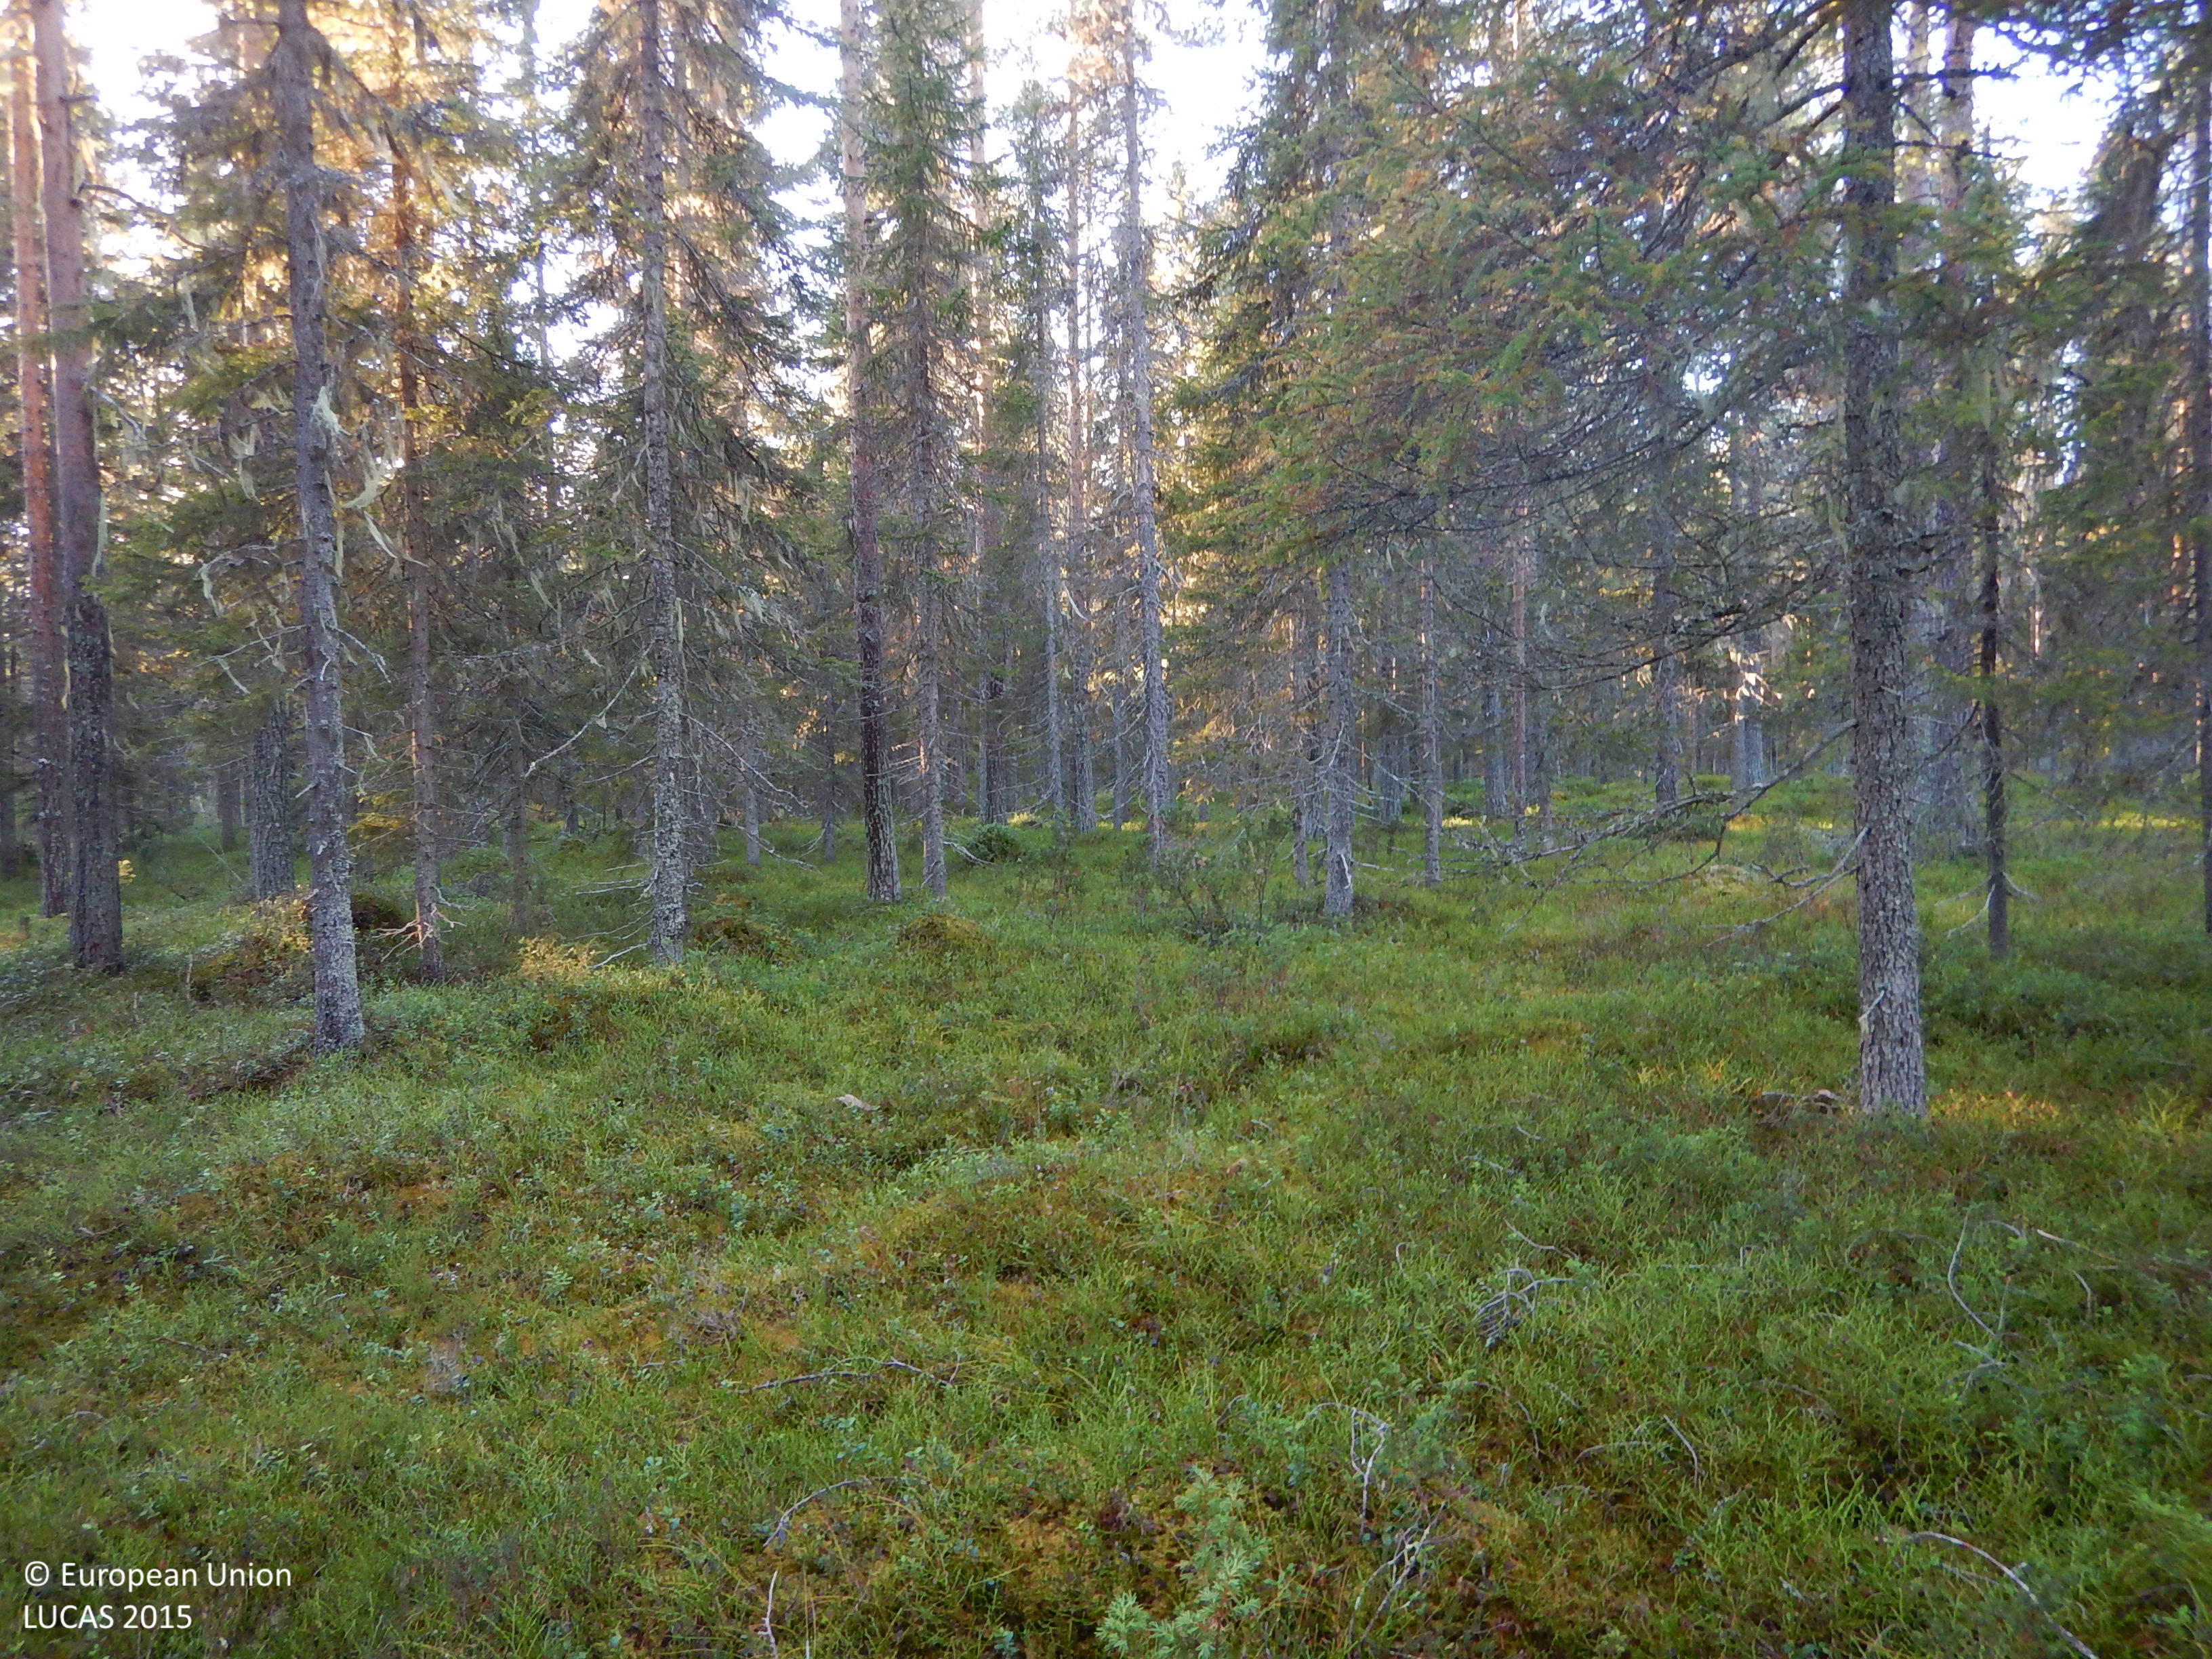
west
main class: Woodland
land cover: Other coniferous woodland
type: boreal forest
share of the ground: 50 - 75 %
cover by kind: coniferous forest trees 65 %, shrubs 15 %, lichens and mosses 15 %, herbaceous plants 5 %
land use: Forestry
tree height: > 5 m
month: November
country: SE
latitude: 65.2875
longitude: 21.0994
